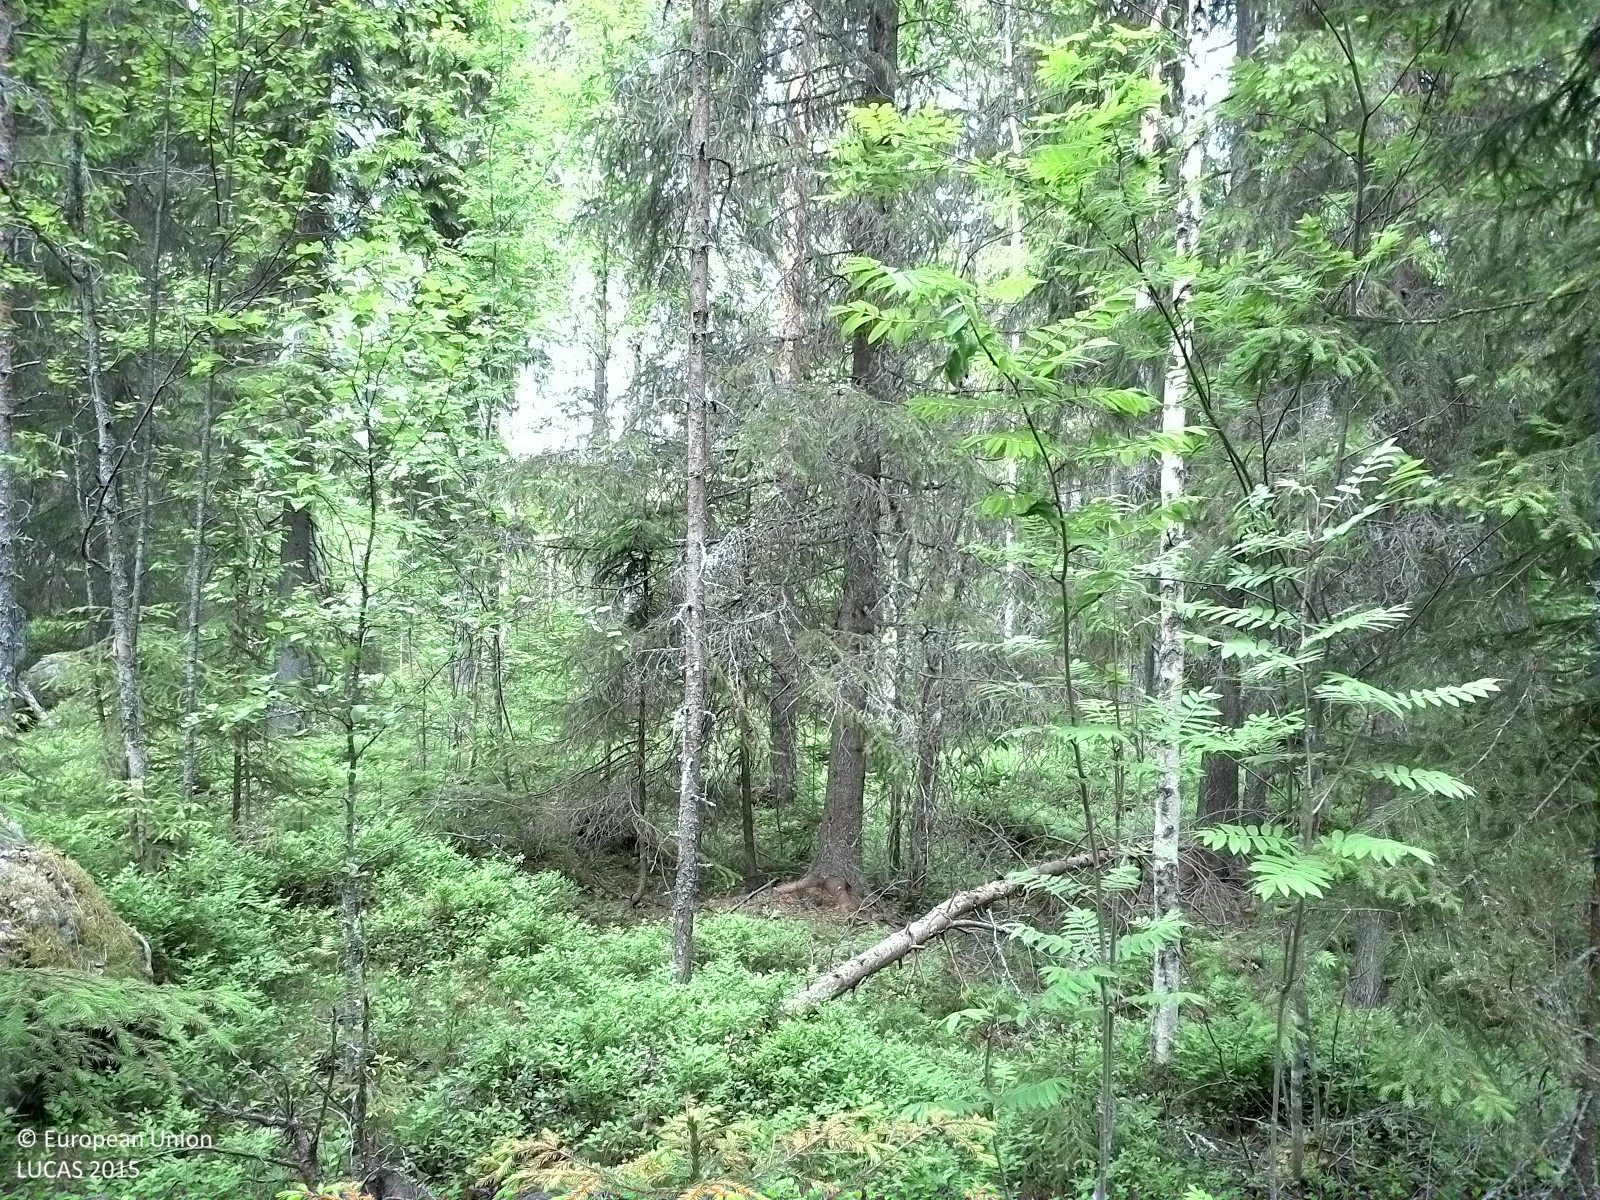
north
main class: Woodland
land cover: Pine dominated mixed woodland
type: boreal forest
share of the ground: 50 - 75 %
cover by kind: coniferous forest trees 35 %, shrubs 30 %, broadleaved forest trees 25 %, lichens and mosses 10 %
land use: Forestry
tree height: > 5 m
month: June
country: SE
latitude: 62.0491
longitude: 16.2351
